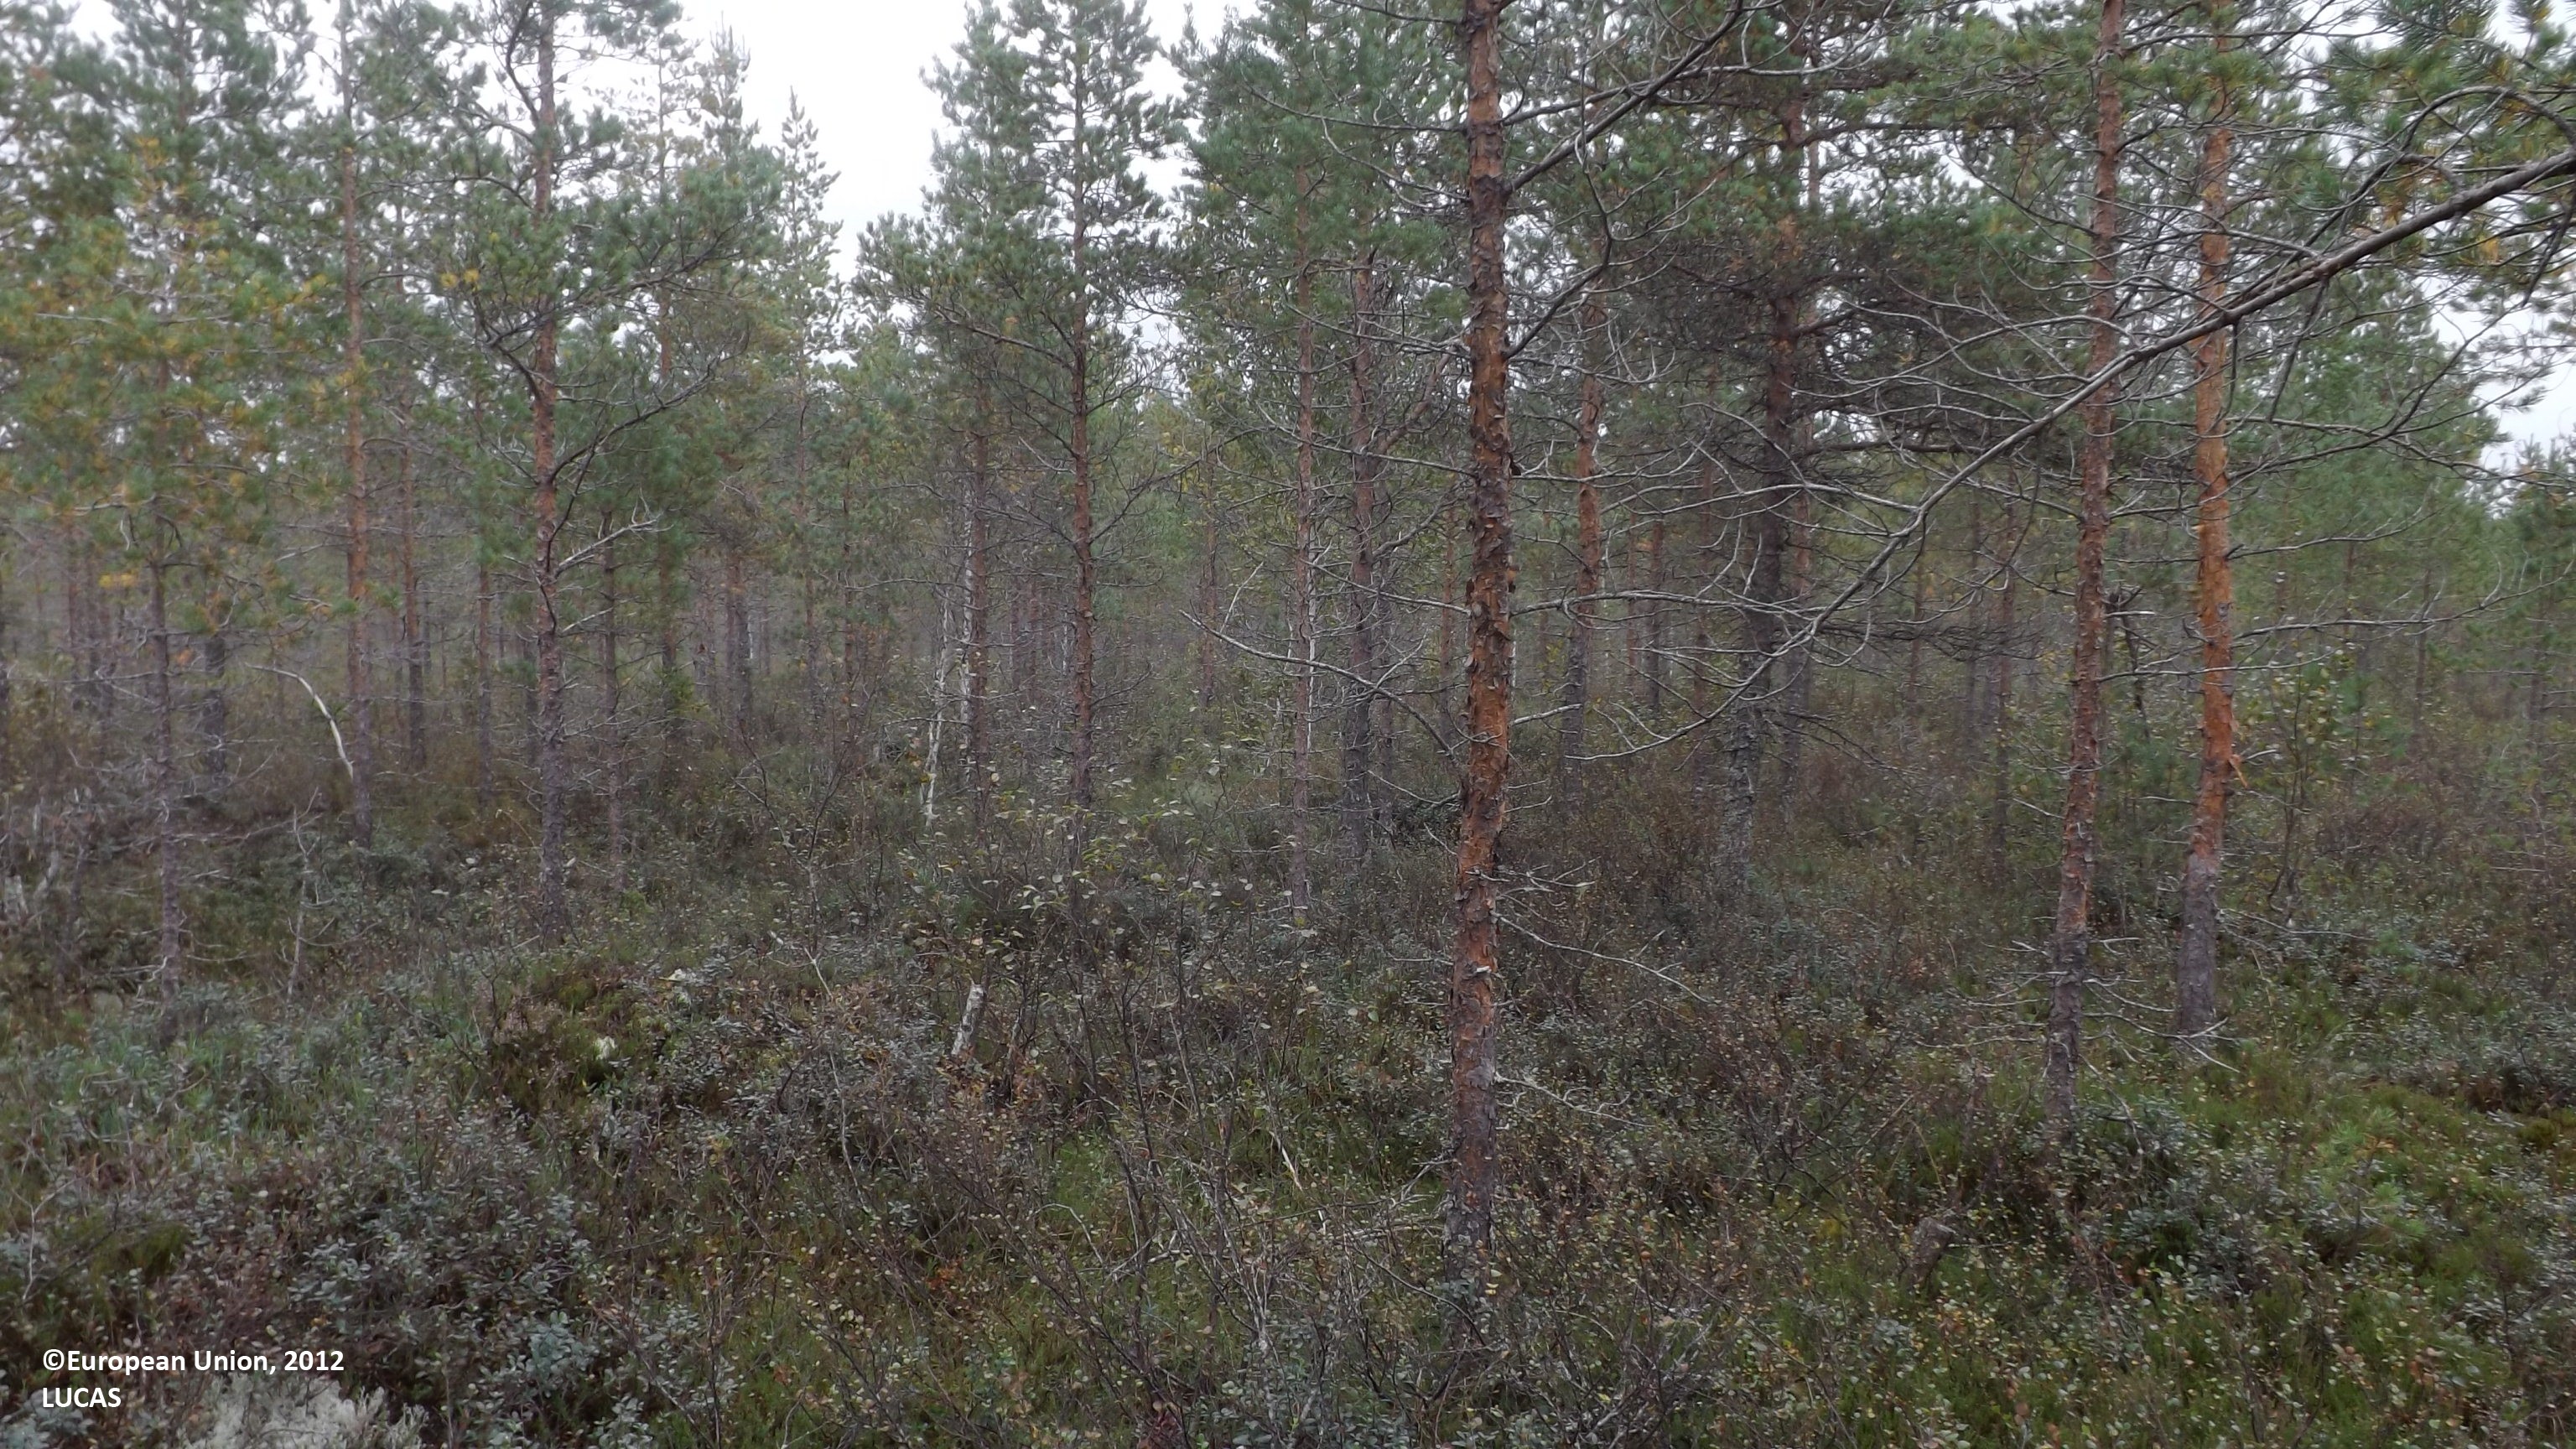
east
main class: Woodland
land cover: Pine dominated coniferous woodland
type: mire and swamp forests
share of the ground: 50 - 75 %
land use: Forestry
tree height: > 5 m
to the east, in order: Pine dominated coniferous woodland; Ditches and canals; Pine dominated coniferous woodland; Ditches and canals; Pine dominated mixed woodland; Ditches and canals; Other mixed woodland
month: August
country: FI
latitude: 63.9251
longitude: 23.9518
